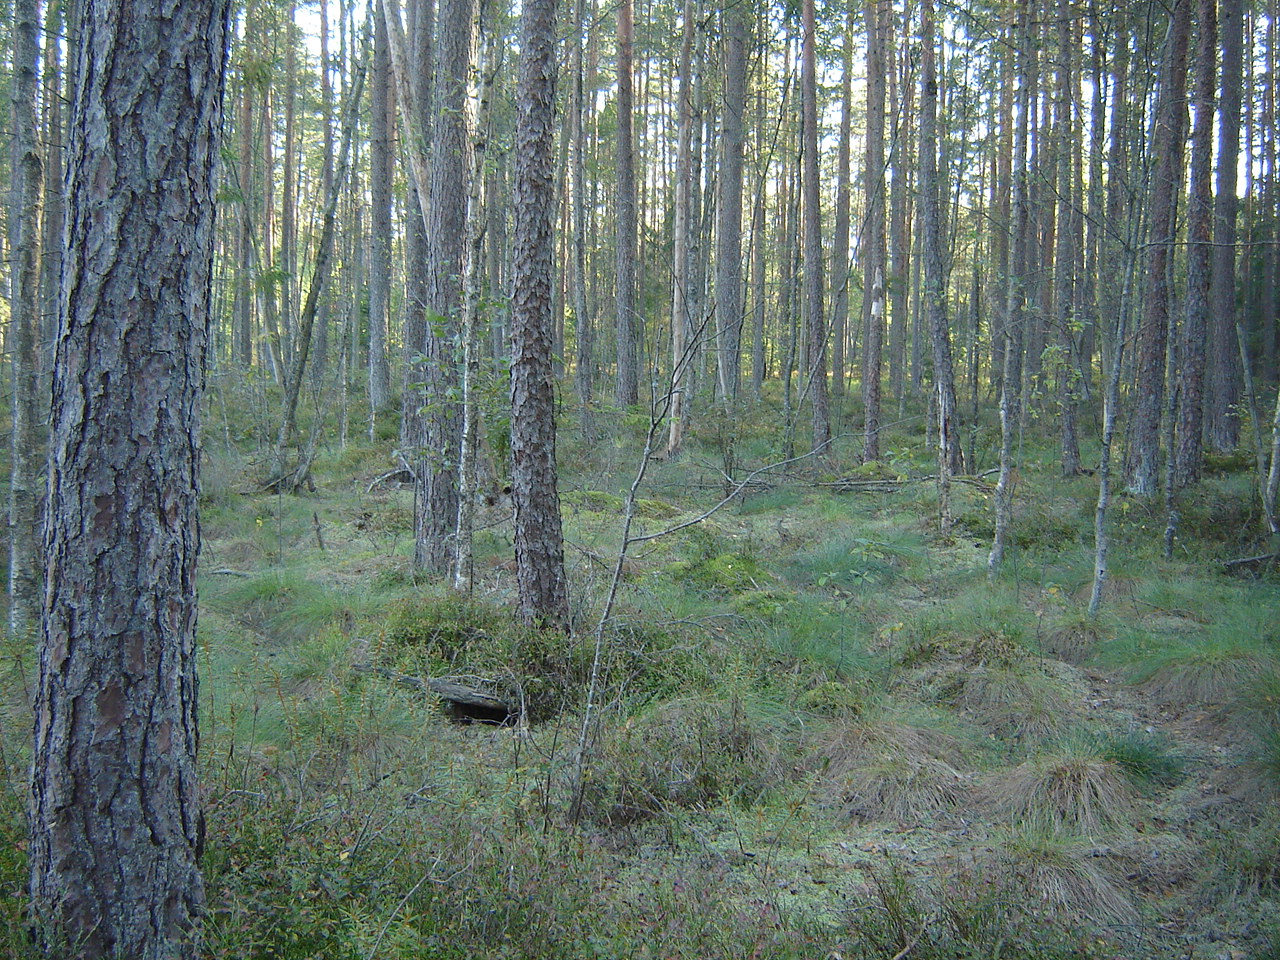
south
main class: Woodland
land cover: Pine dominated coniferous woodland
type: hemiboreal forest and nemoral coniferous forest and mixed broadleaved-coniferous forest
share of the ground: > 75 %
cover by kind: coniferous forest trees 75 %, shrubs 10 %, lichens and mosses 10 %, broadleaved forest trees 5 %
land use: Forestry
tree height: > 5 m
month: September
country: LT
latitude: 54.3460
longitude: 25.1485
